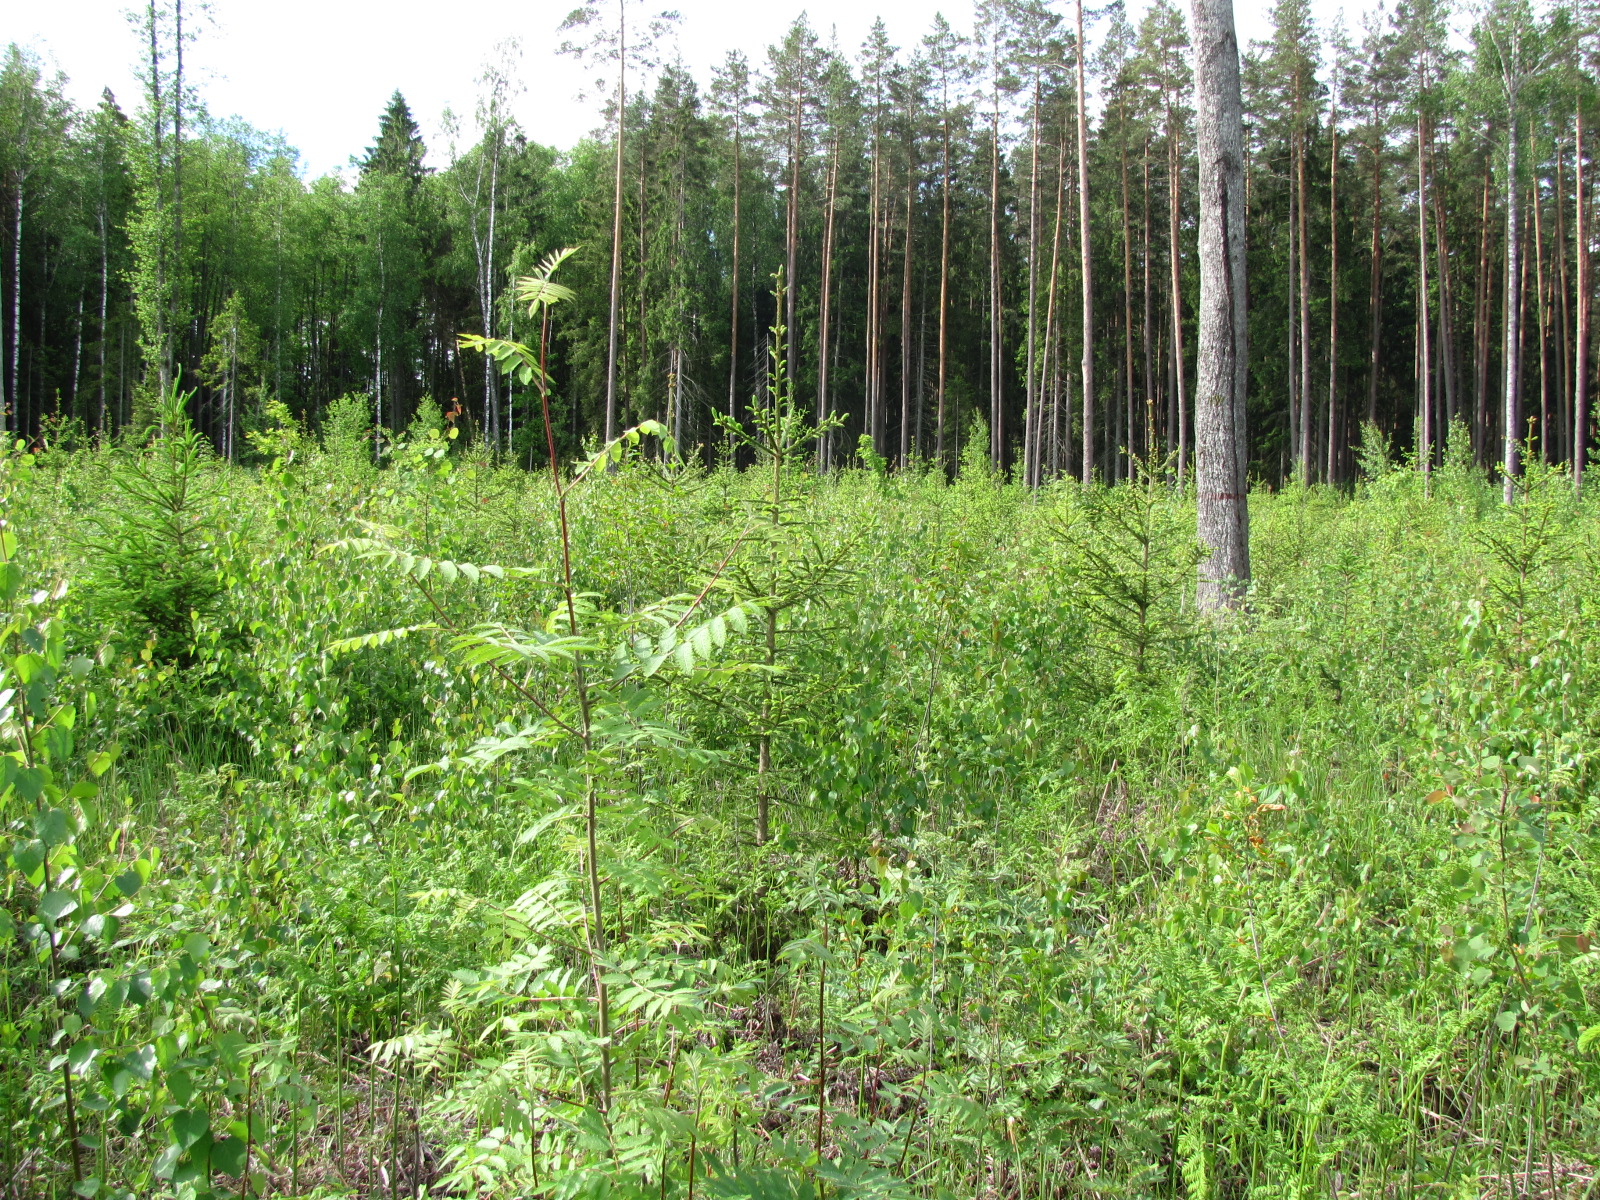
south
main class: Woodland
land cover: Spruce dominated mixed woodland
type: hemiboreal forest and nemoral coniferous forest and mixed broadleaved-coniferous forest
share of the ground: 50 - 75 %
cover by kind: broadleaved forest trees 40 %, coniferous forest trees 30 %, herbaceous plants 30 %
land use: Forestry
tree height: < 5 m
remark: Nursery
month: June
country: LV
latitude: 56.7005
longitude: 23.9487
